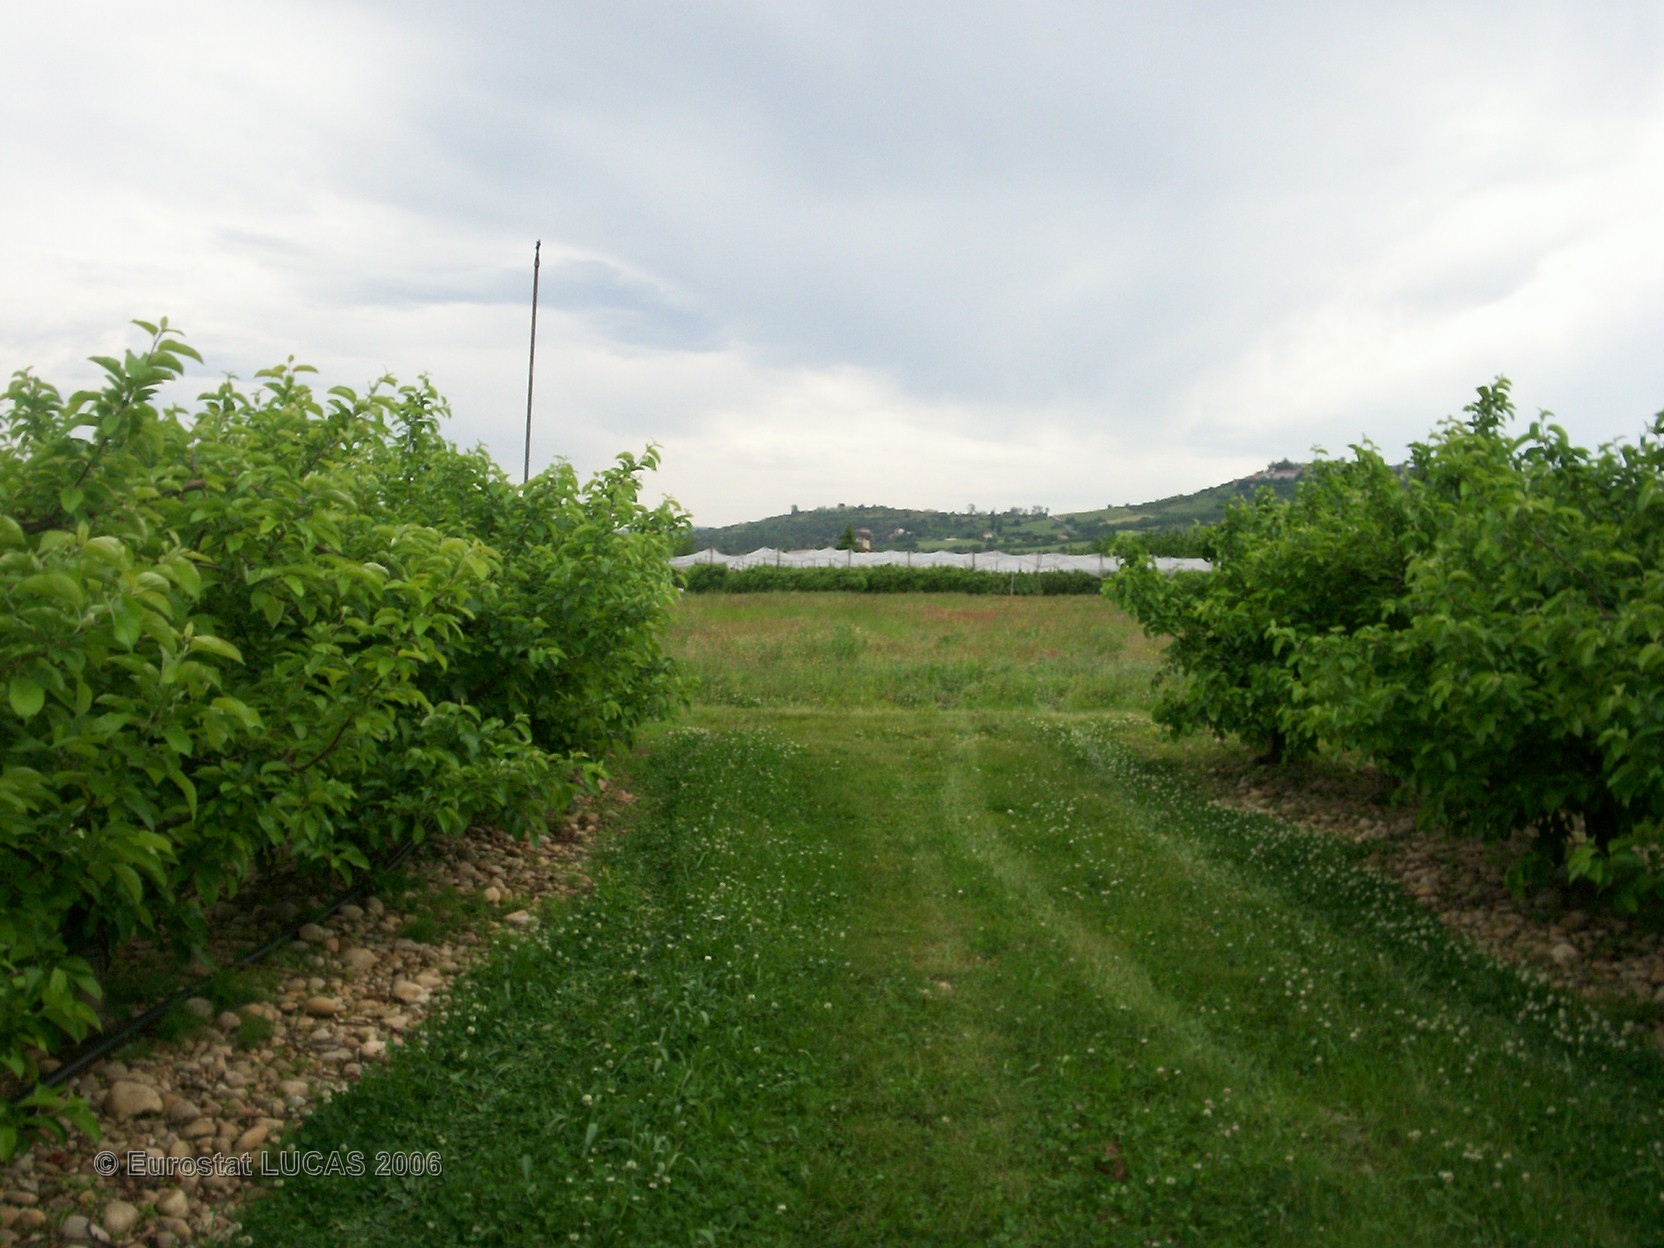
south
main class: Cropland
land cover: Pear fruit
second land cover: Grassland with sparse tree/shrub cover
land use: Agriculture (excluding fallow land and kitchen gardens)
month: May
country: FR
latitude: 45.6450
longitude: 4.7560
